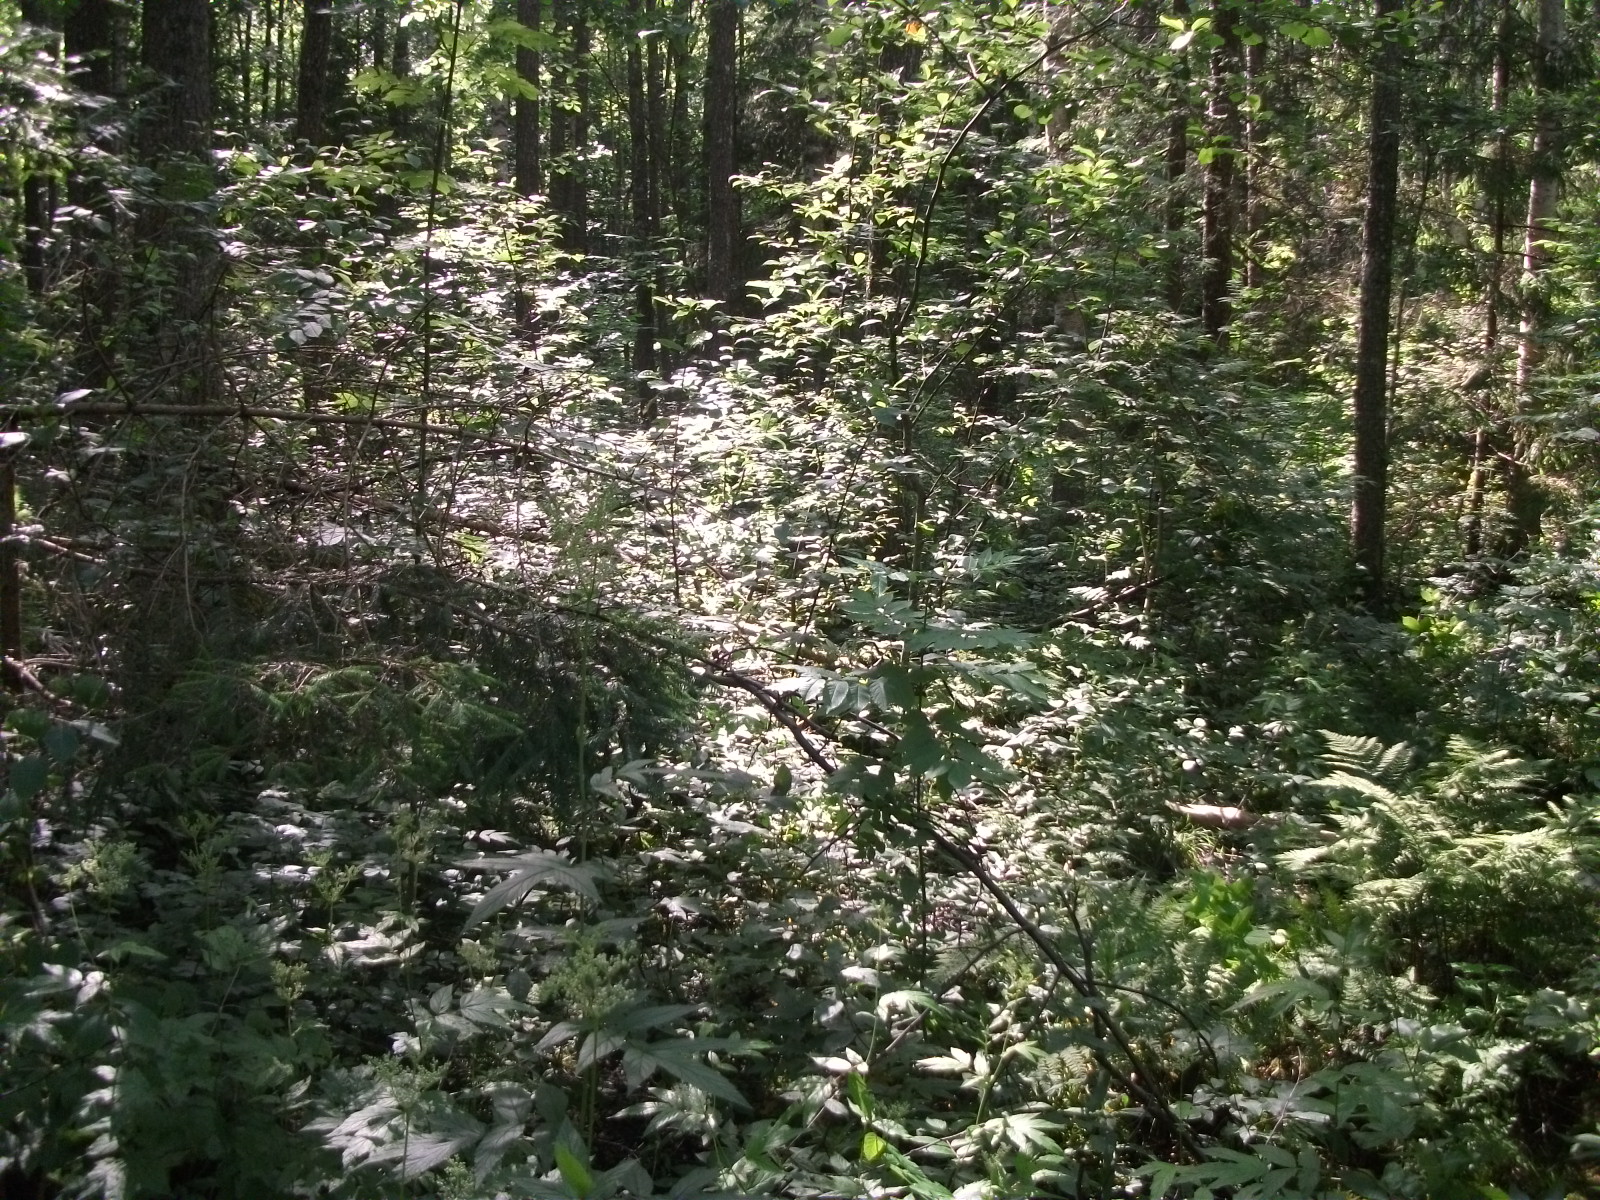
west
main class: Woodland
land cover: Broadleaved woodland
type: non-riverine alder, birch or aspen forest
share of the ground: > 75 %
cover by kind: broadleaved forest trees 85 %, coniferous forest trees 5 %, shrubs 5 %, herbaceous plants 5 %
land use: Forestry
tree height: > 5 m
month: June
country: LV
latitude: 57.0108
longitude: 26.7351
